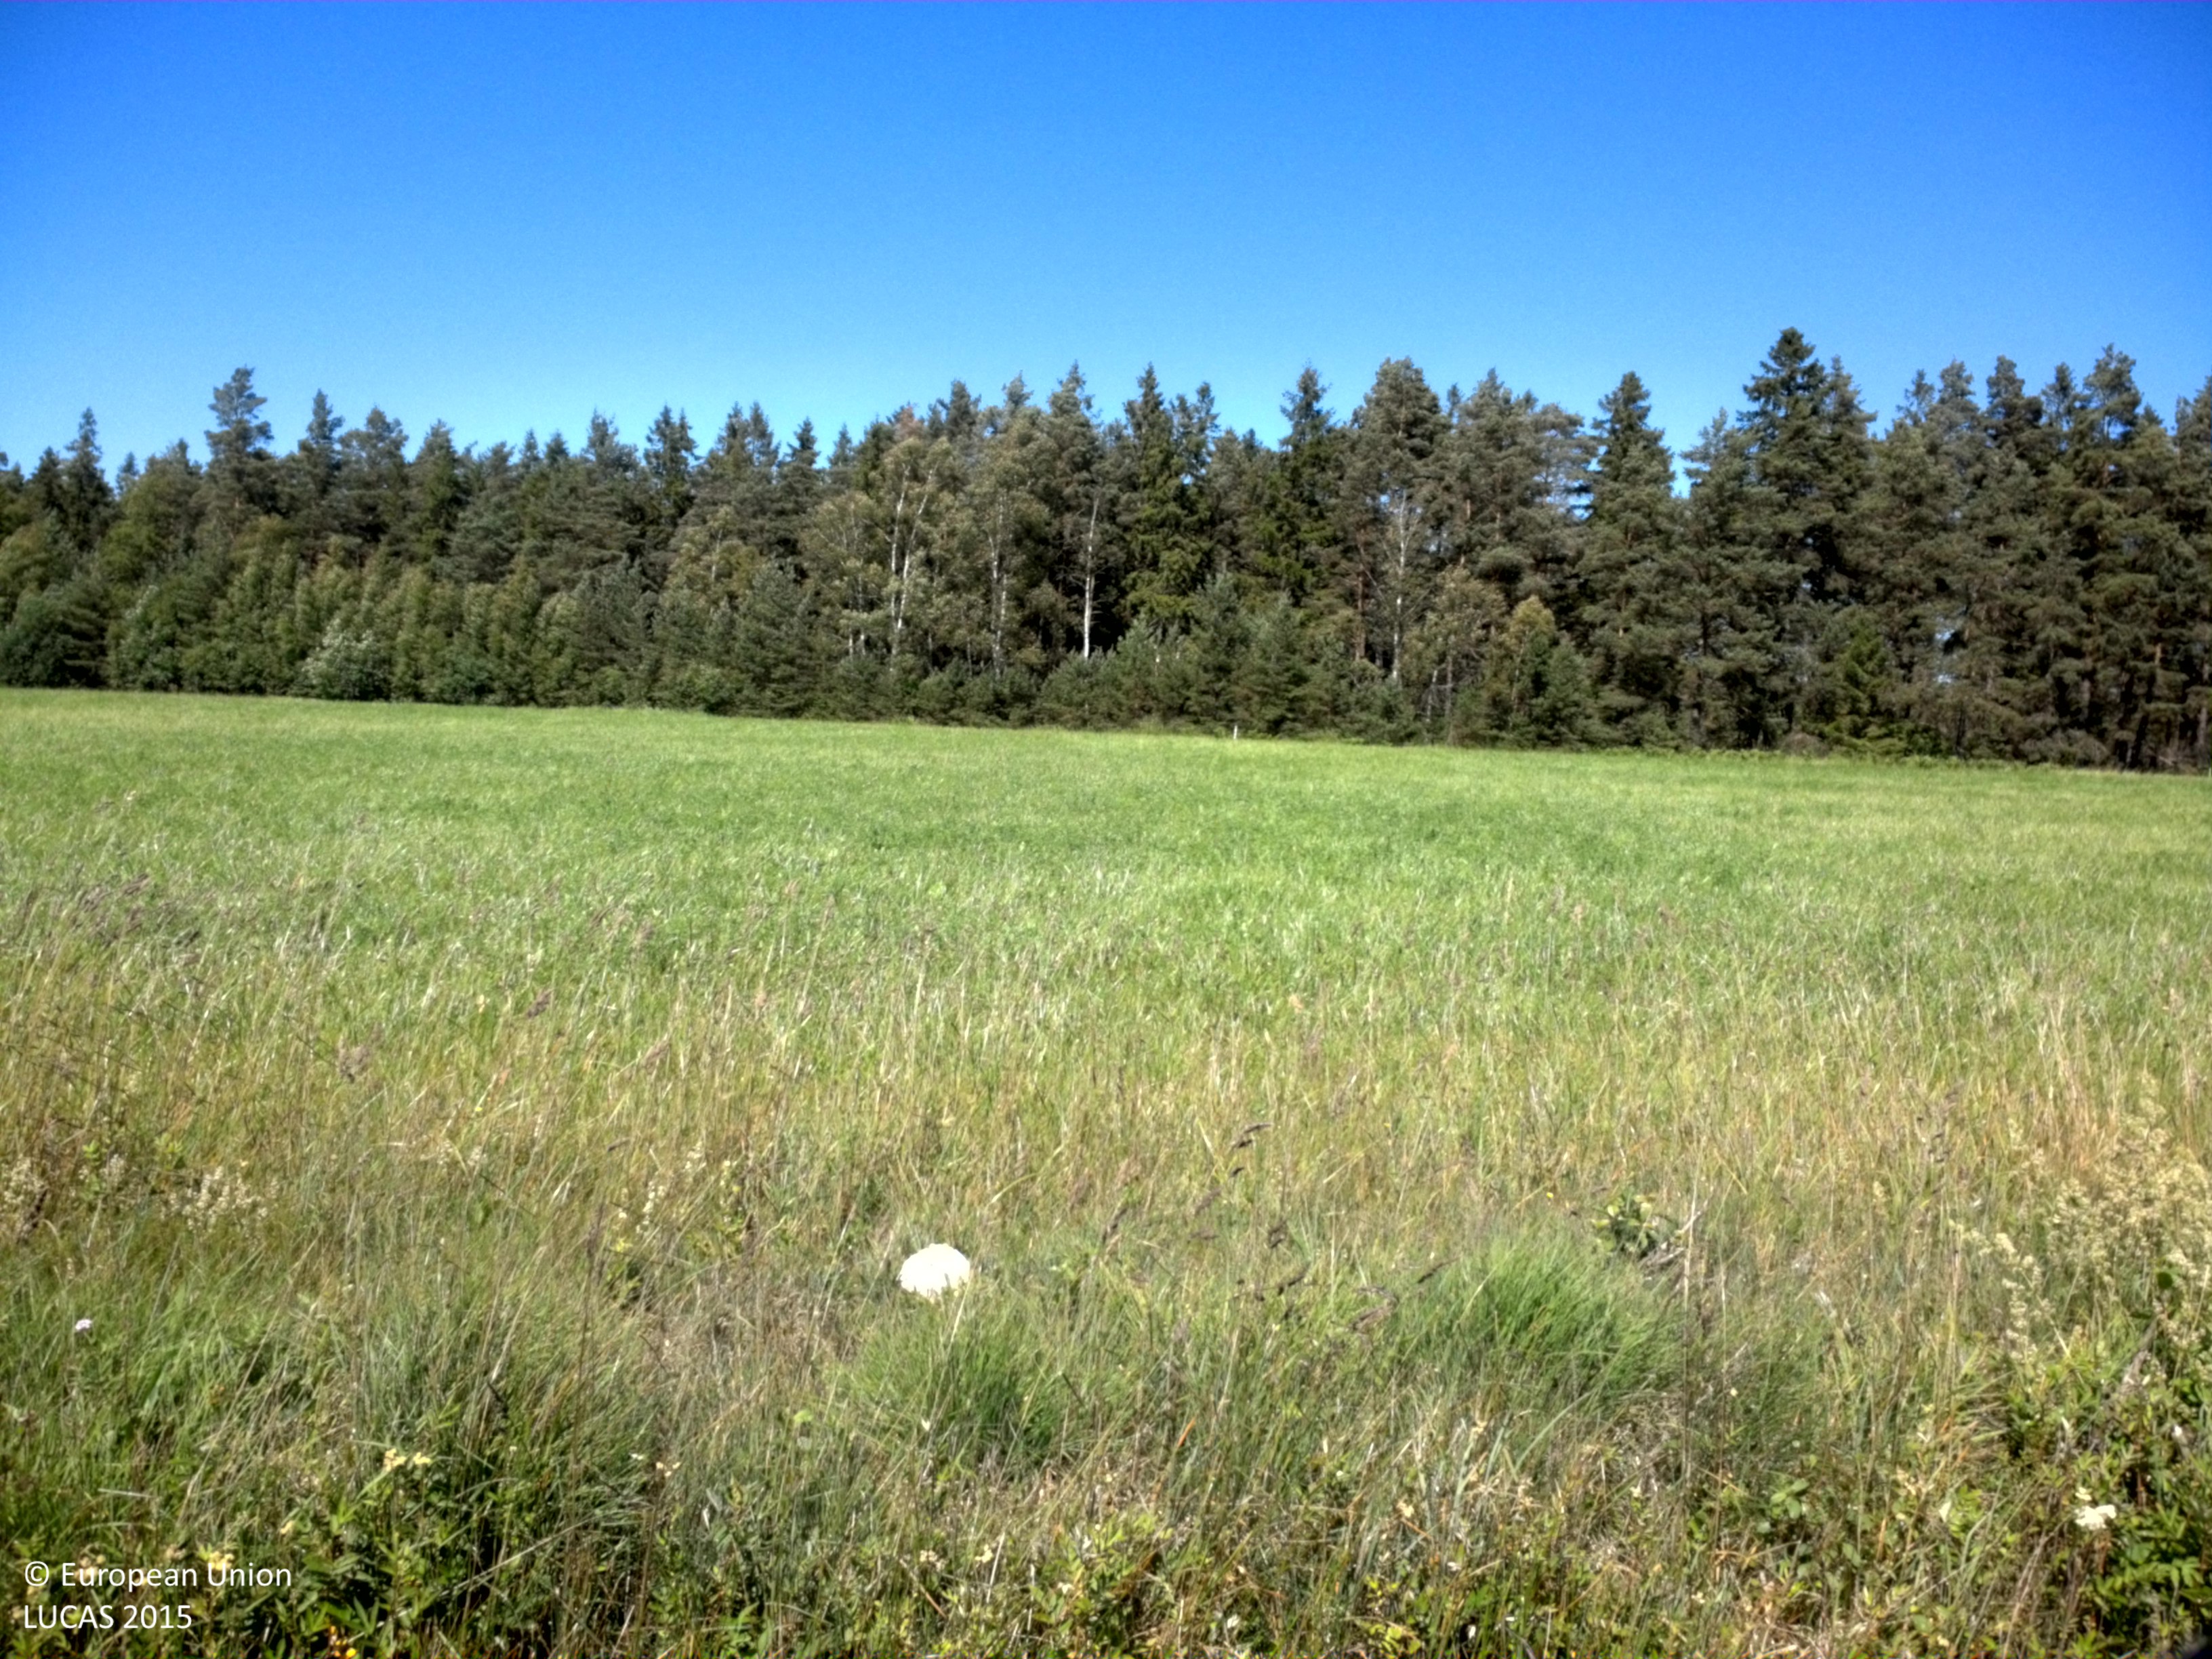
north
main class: Cropland
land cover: Lucerne
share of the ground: > 75 %
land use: Agriculture (excluding fallow land and kitchen gardens)
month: July
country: SE
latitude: 57.8075
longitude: 18.7434
